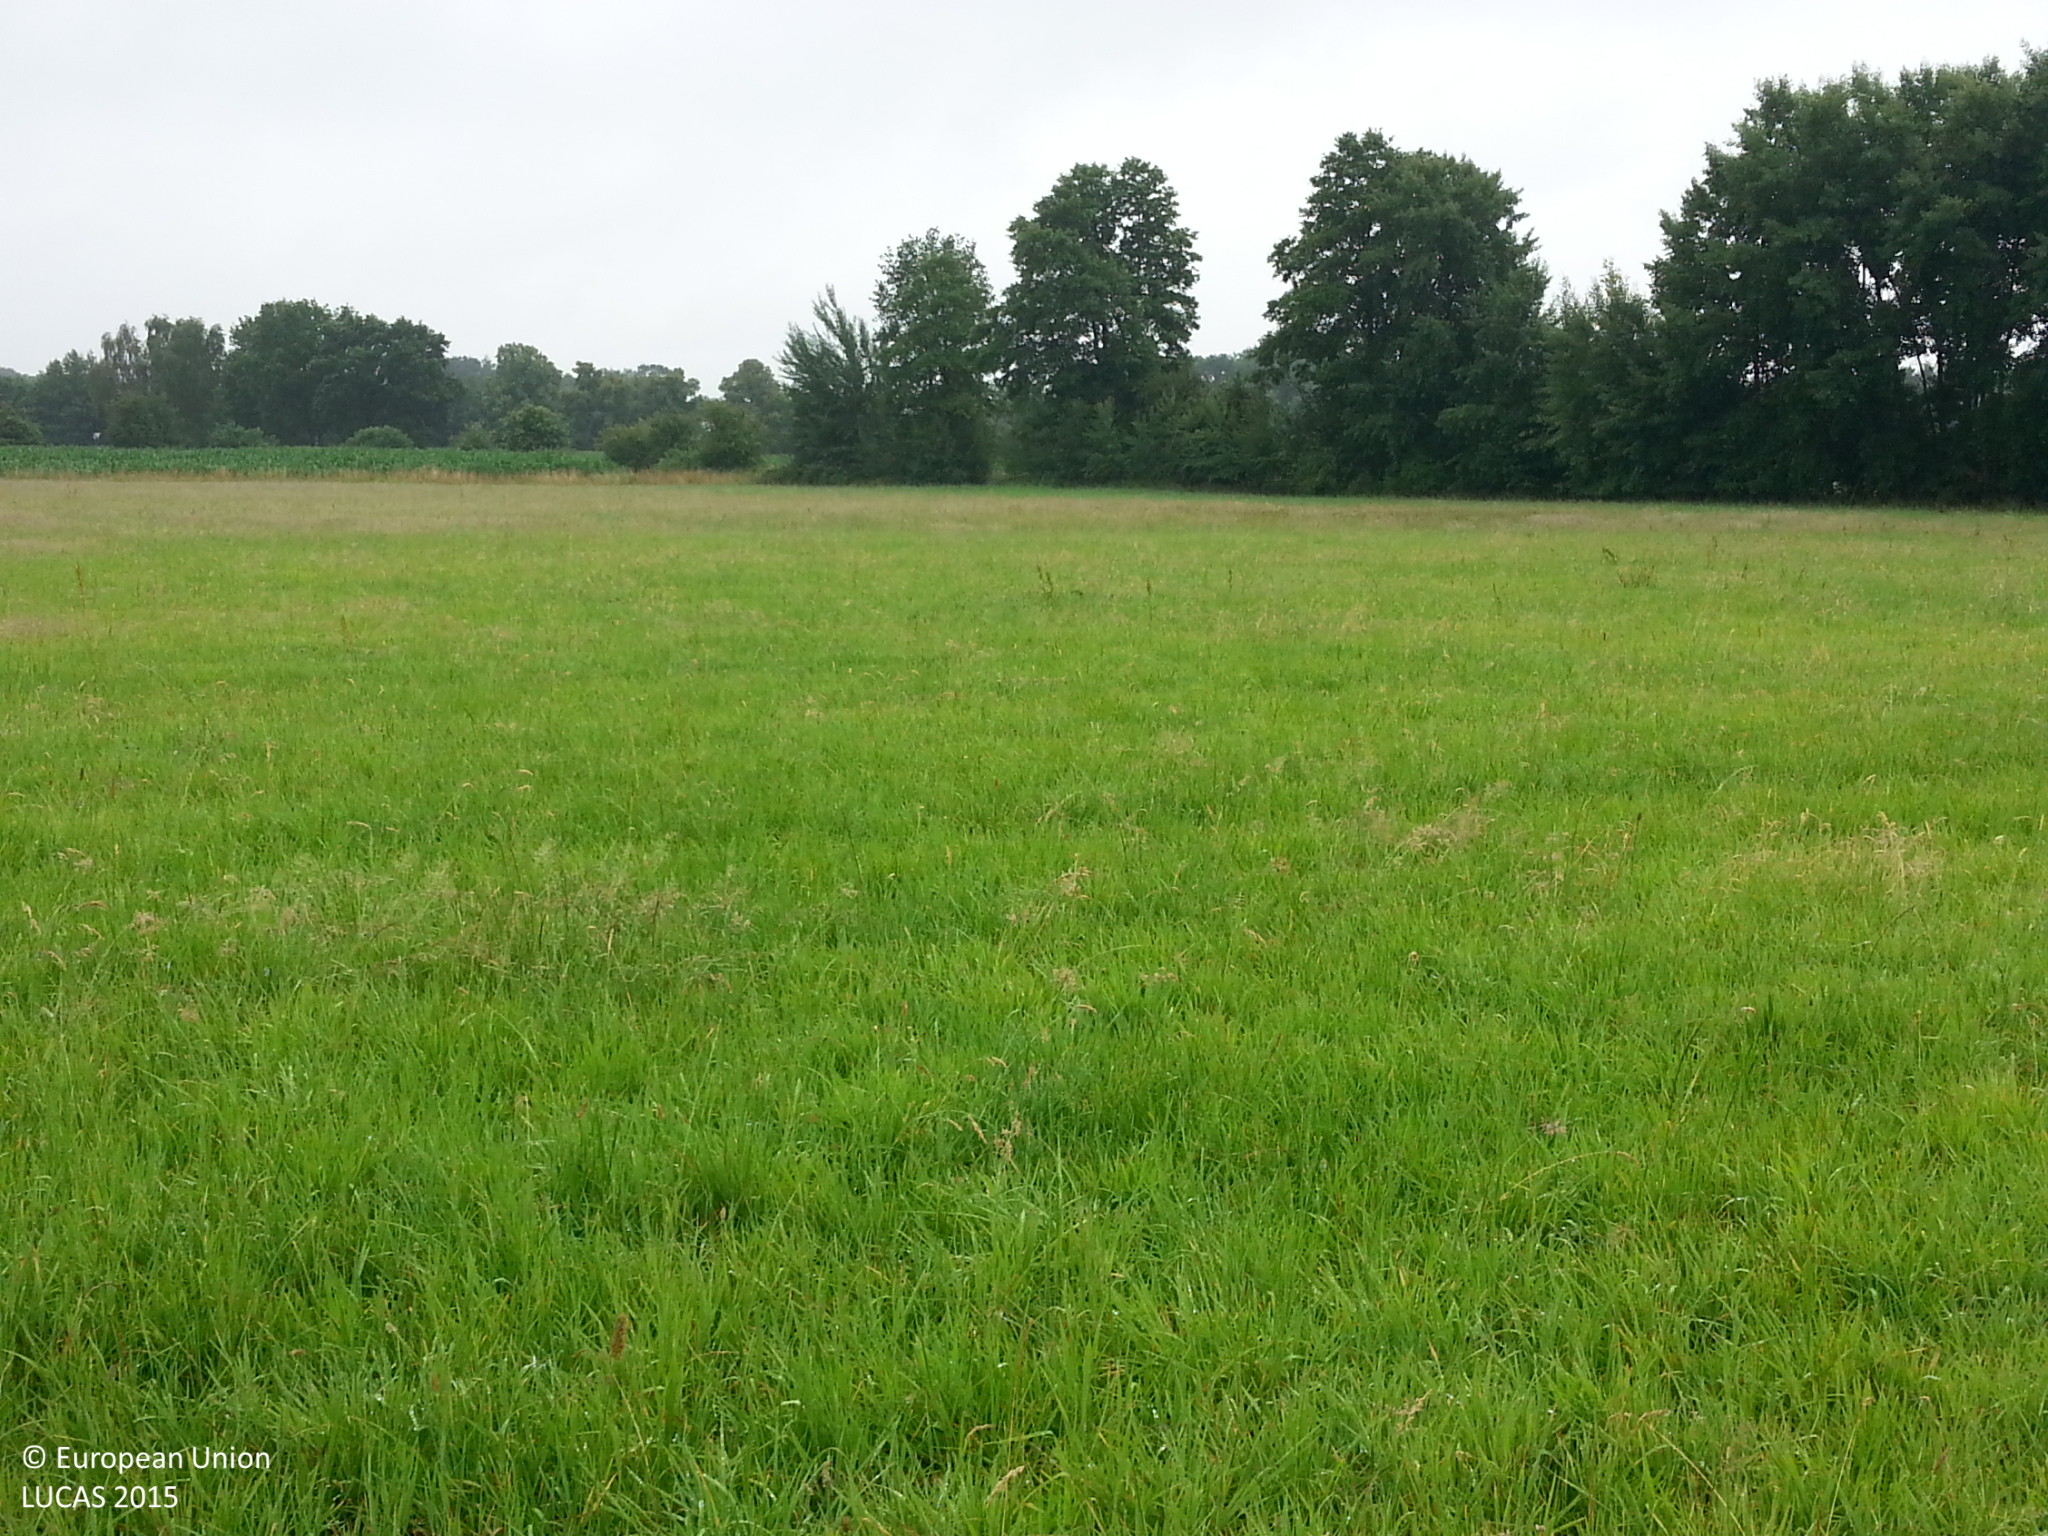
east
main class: Cropland
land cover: Maize
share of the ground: > 75 %
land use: Agriculture (excluding fallow land and kitchen gardens)
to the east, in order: Maize; Grassland without tree/shrub cover; Broadleaved woodland; Grass margins; Maize
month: July
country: DE
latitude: 52.9836
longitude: 11.0869
